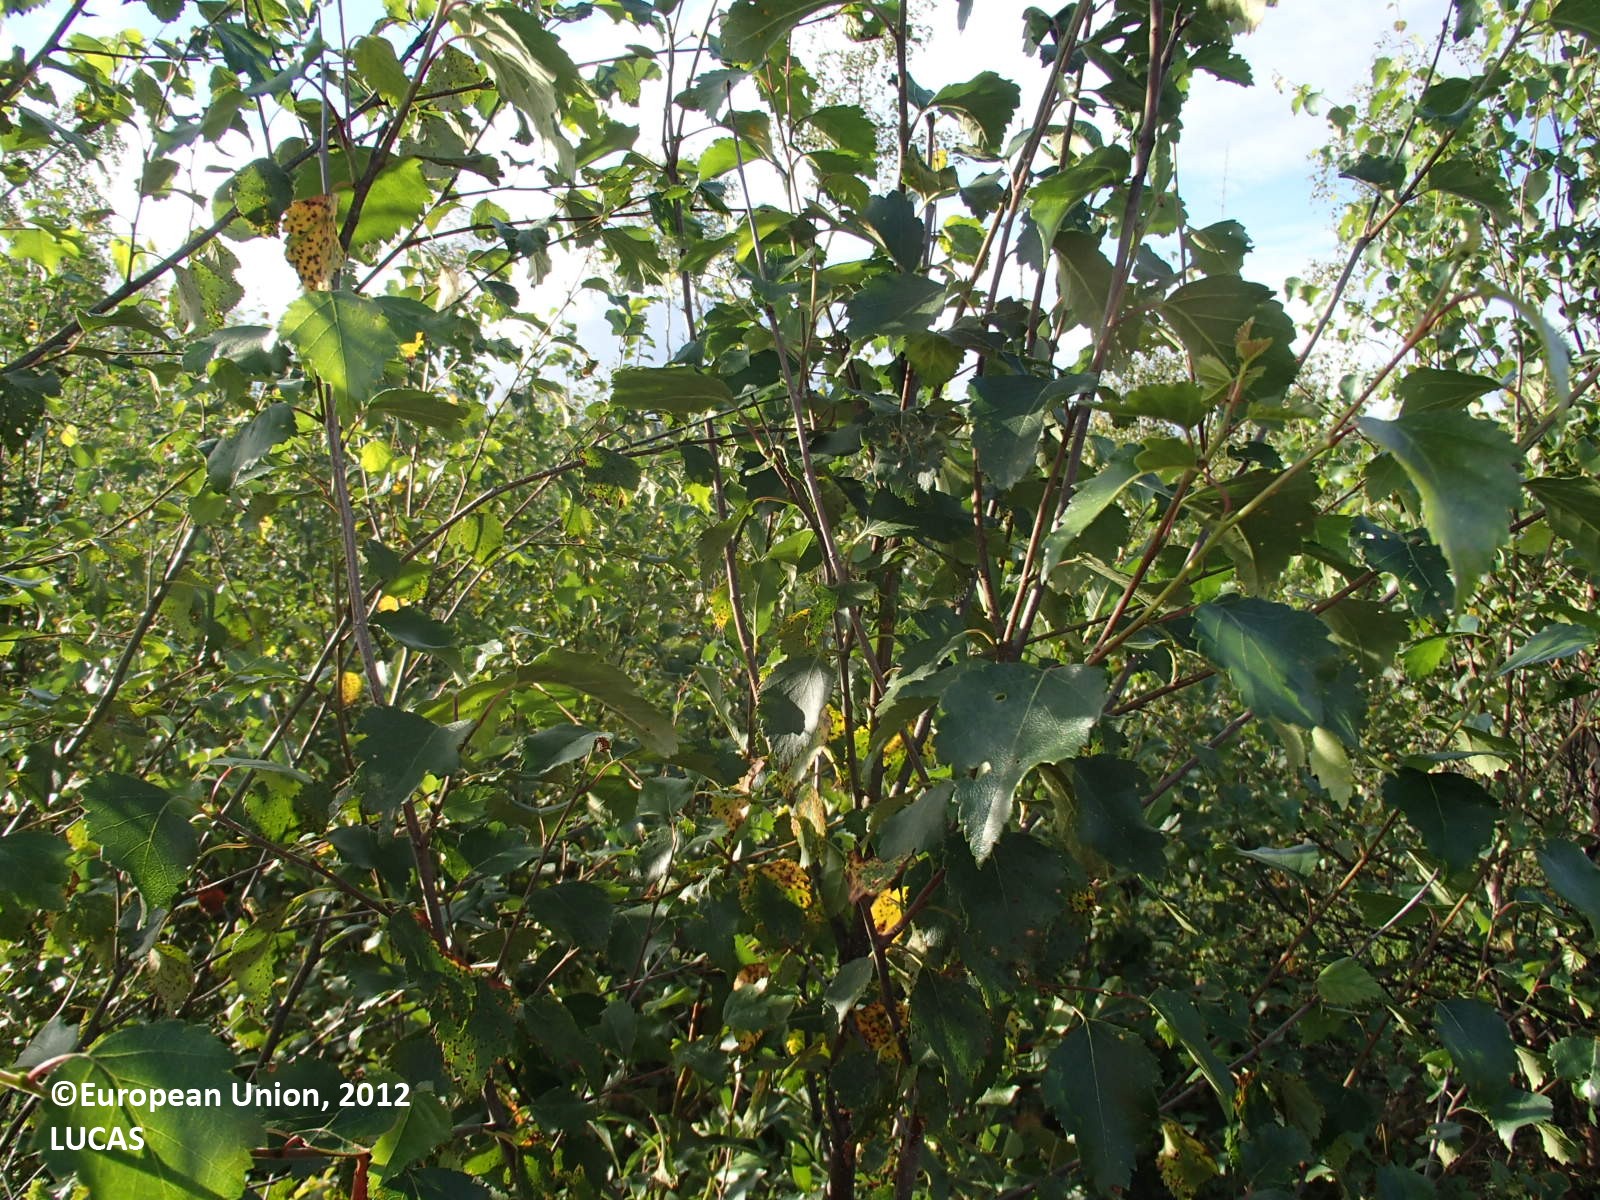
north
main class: Woodland
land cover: Other mixed woodland
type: boreal forest
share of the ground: > 75 %
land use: Forestry
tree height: < 5 m
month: August
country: FI
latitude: 63.8130
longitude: 28.0636
